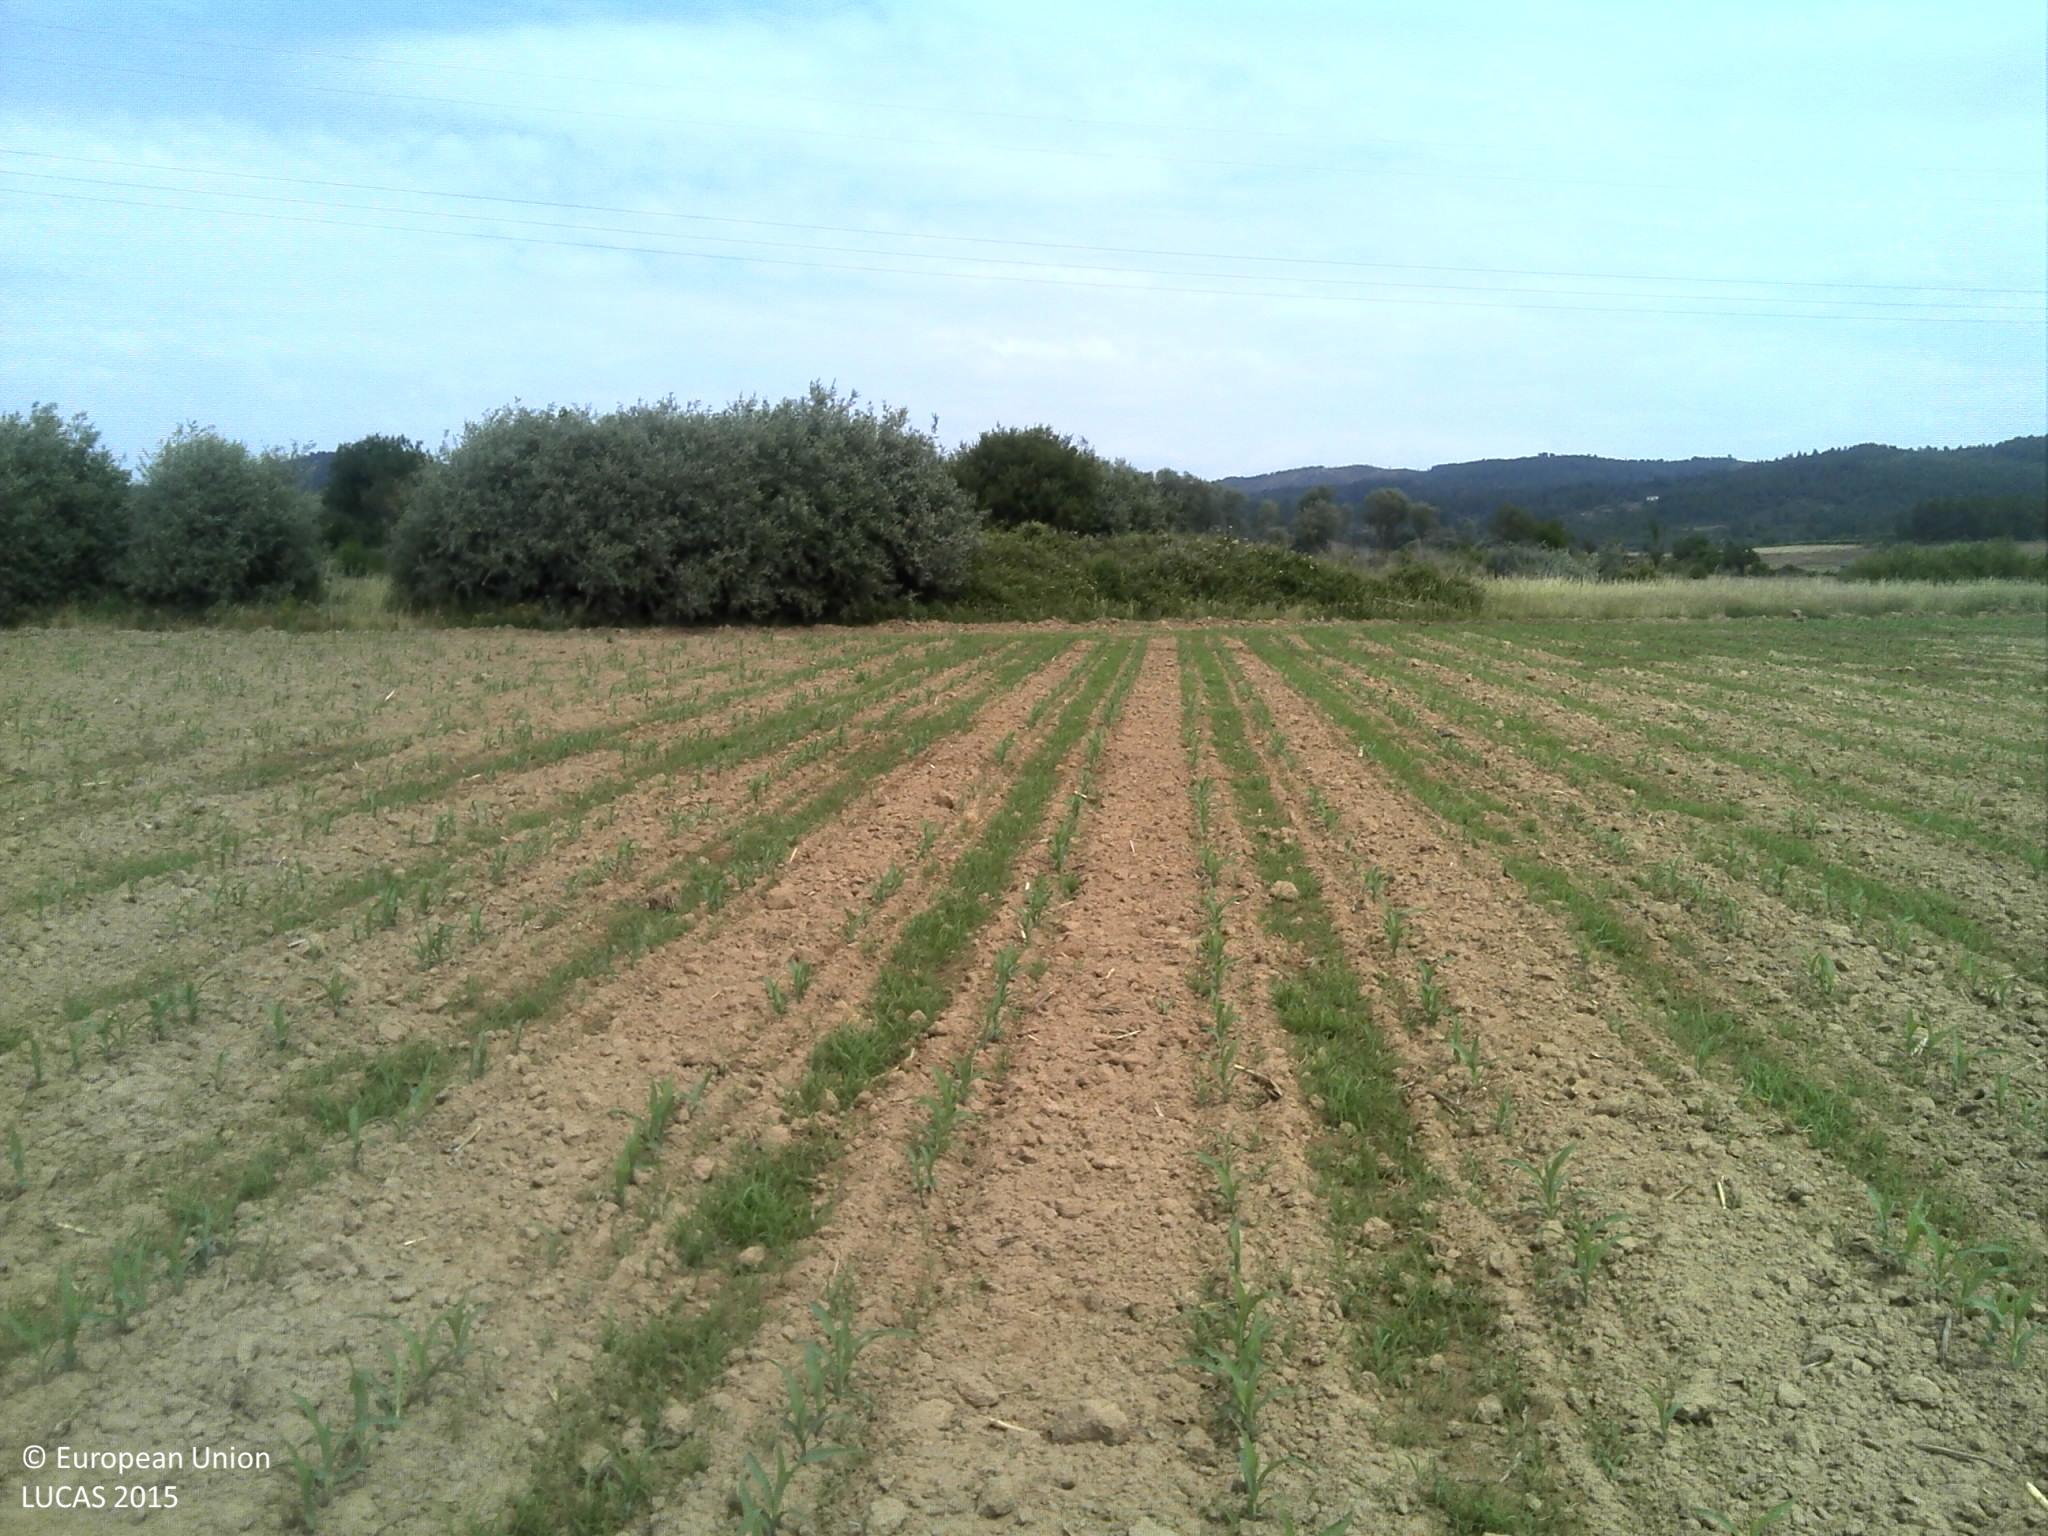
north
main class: Cropland
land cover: Maize
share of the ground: < 10 %
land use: Agriculture (excluding fallow land and kitchen gardens)
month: June
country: PT
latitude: 40.2350
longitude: -7.2730
